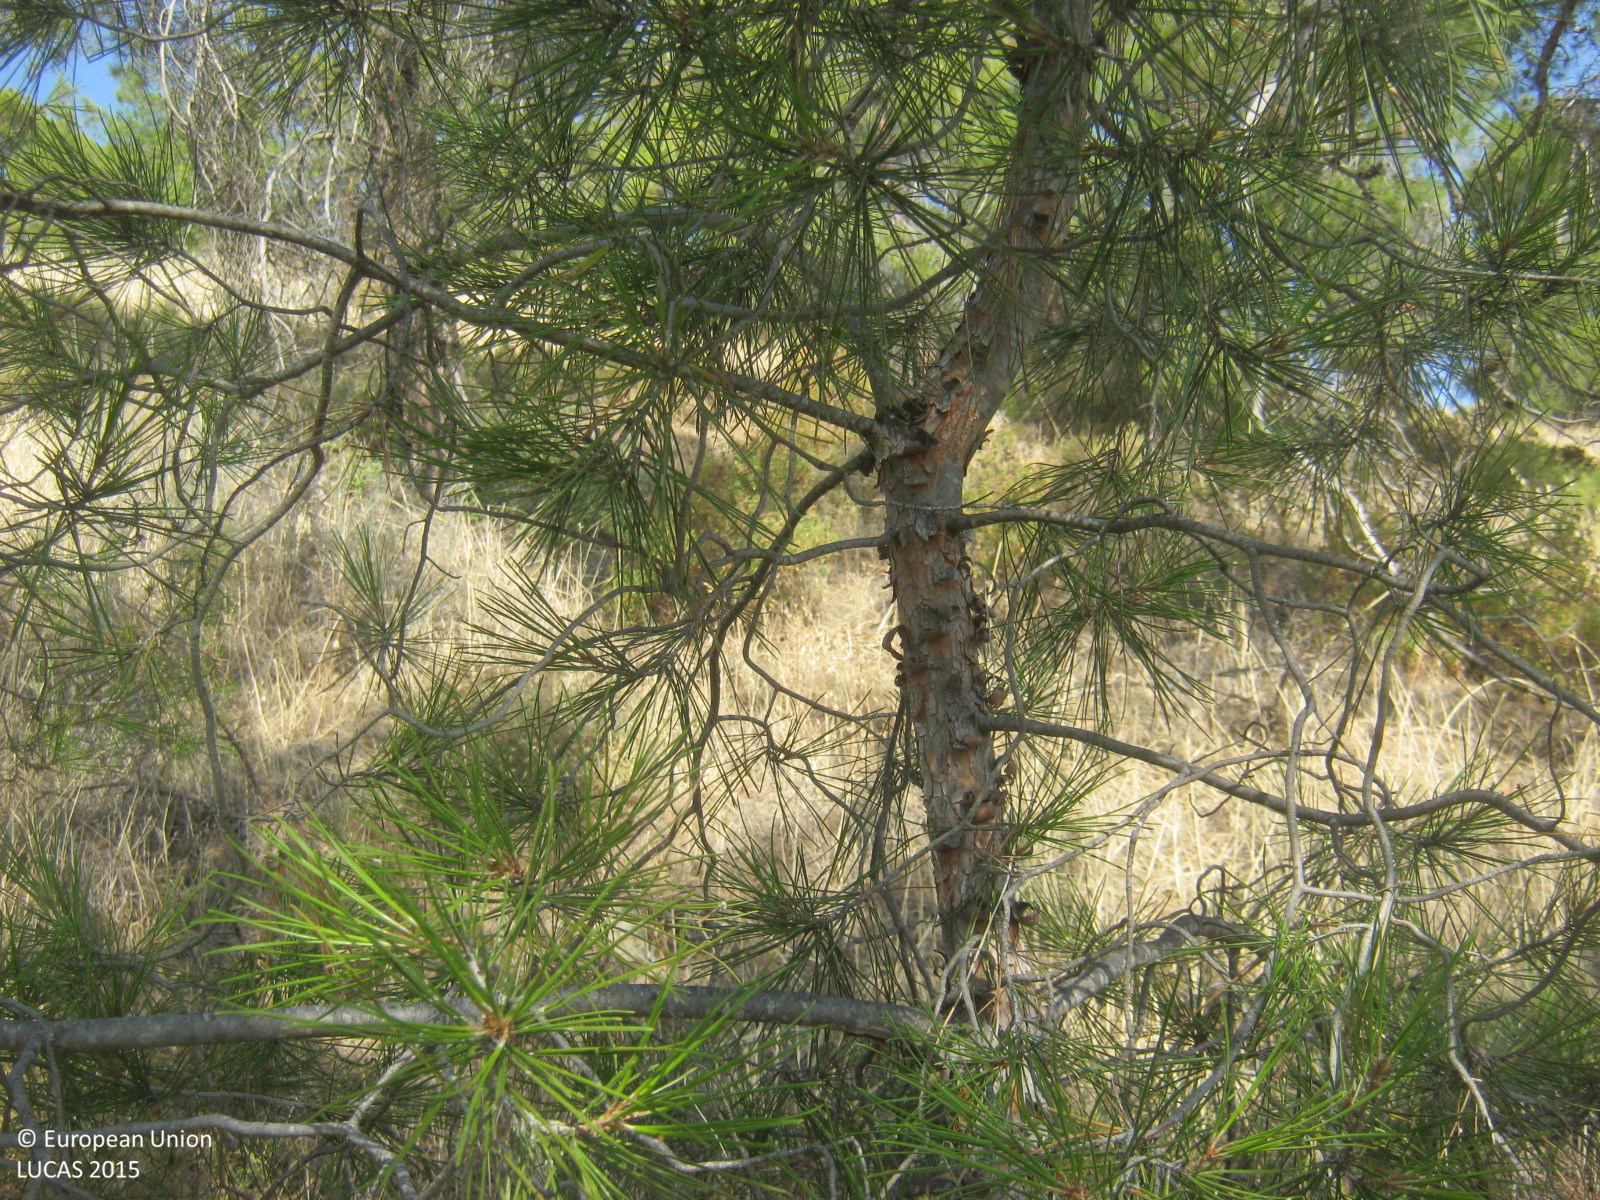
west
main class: Woodland
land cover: Pine dominated coniferous woodland
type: coniferous forest of the mediterranean region
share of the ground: > 75 %
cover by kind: coniferous forest trees 75 %, herbaceous plants 15 %, shrubs 10 %
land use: Forestry
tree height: > 5 m
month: June
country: CY
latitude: 35.0583
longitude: 32.9928
